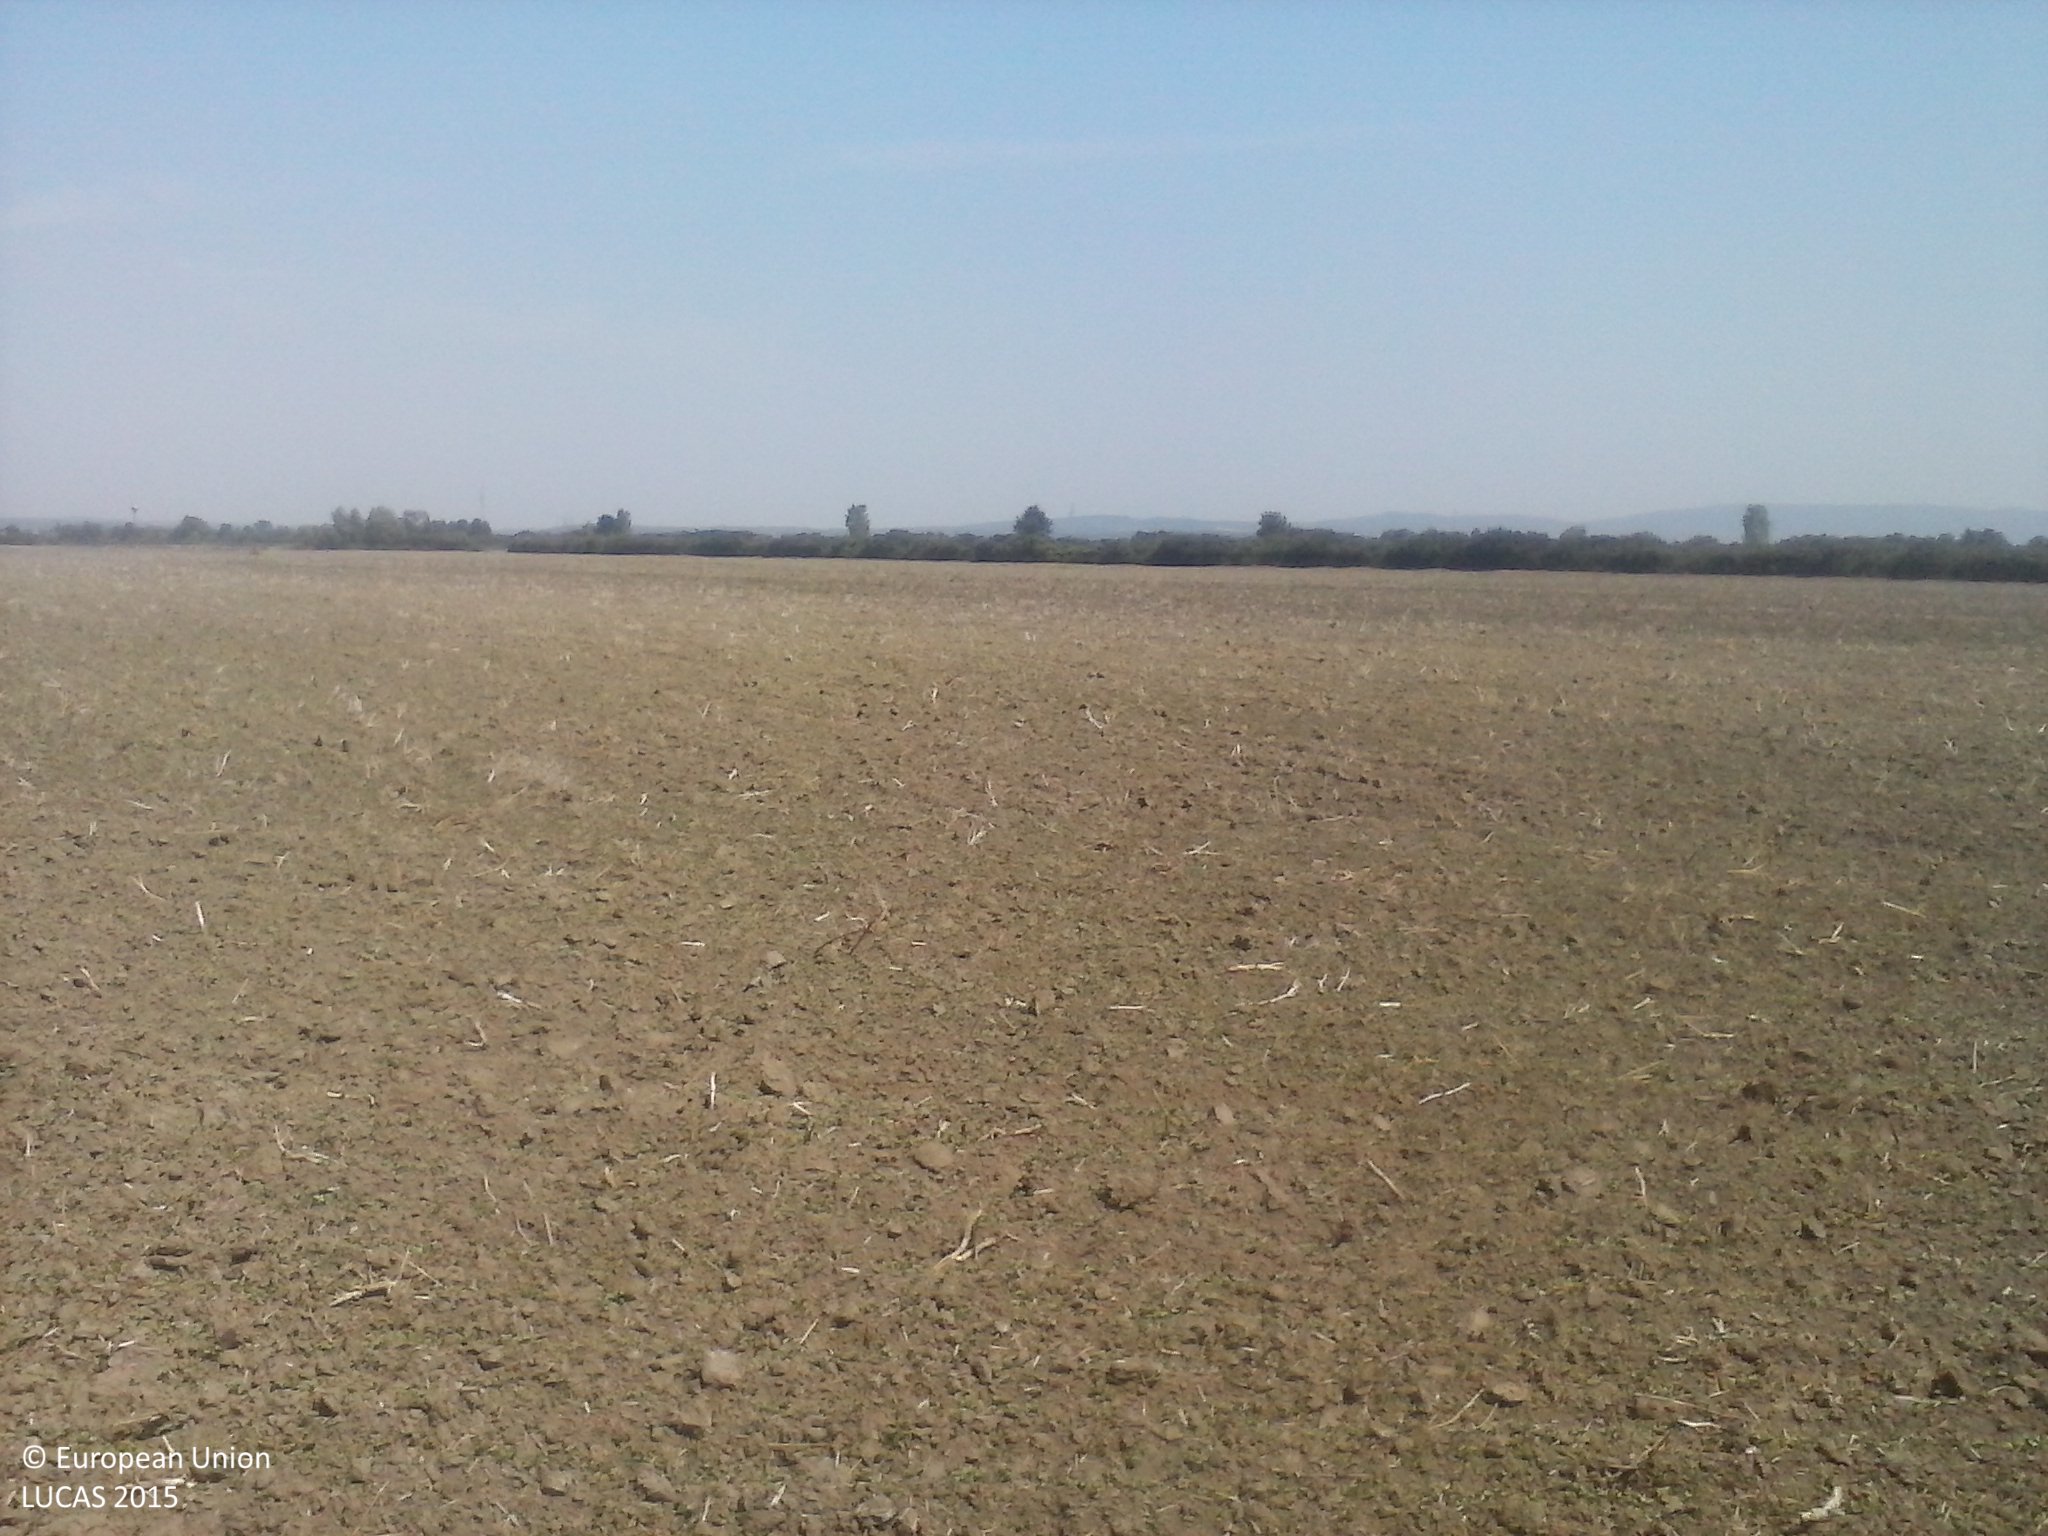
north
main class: Cropland
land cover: Maize
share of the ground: > 75 %
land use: Agriculture (excluding fallow land and kitchen gardens)
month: August
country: HU
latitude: 46.0189
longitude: 17.9493
